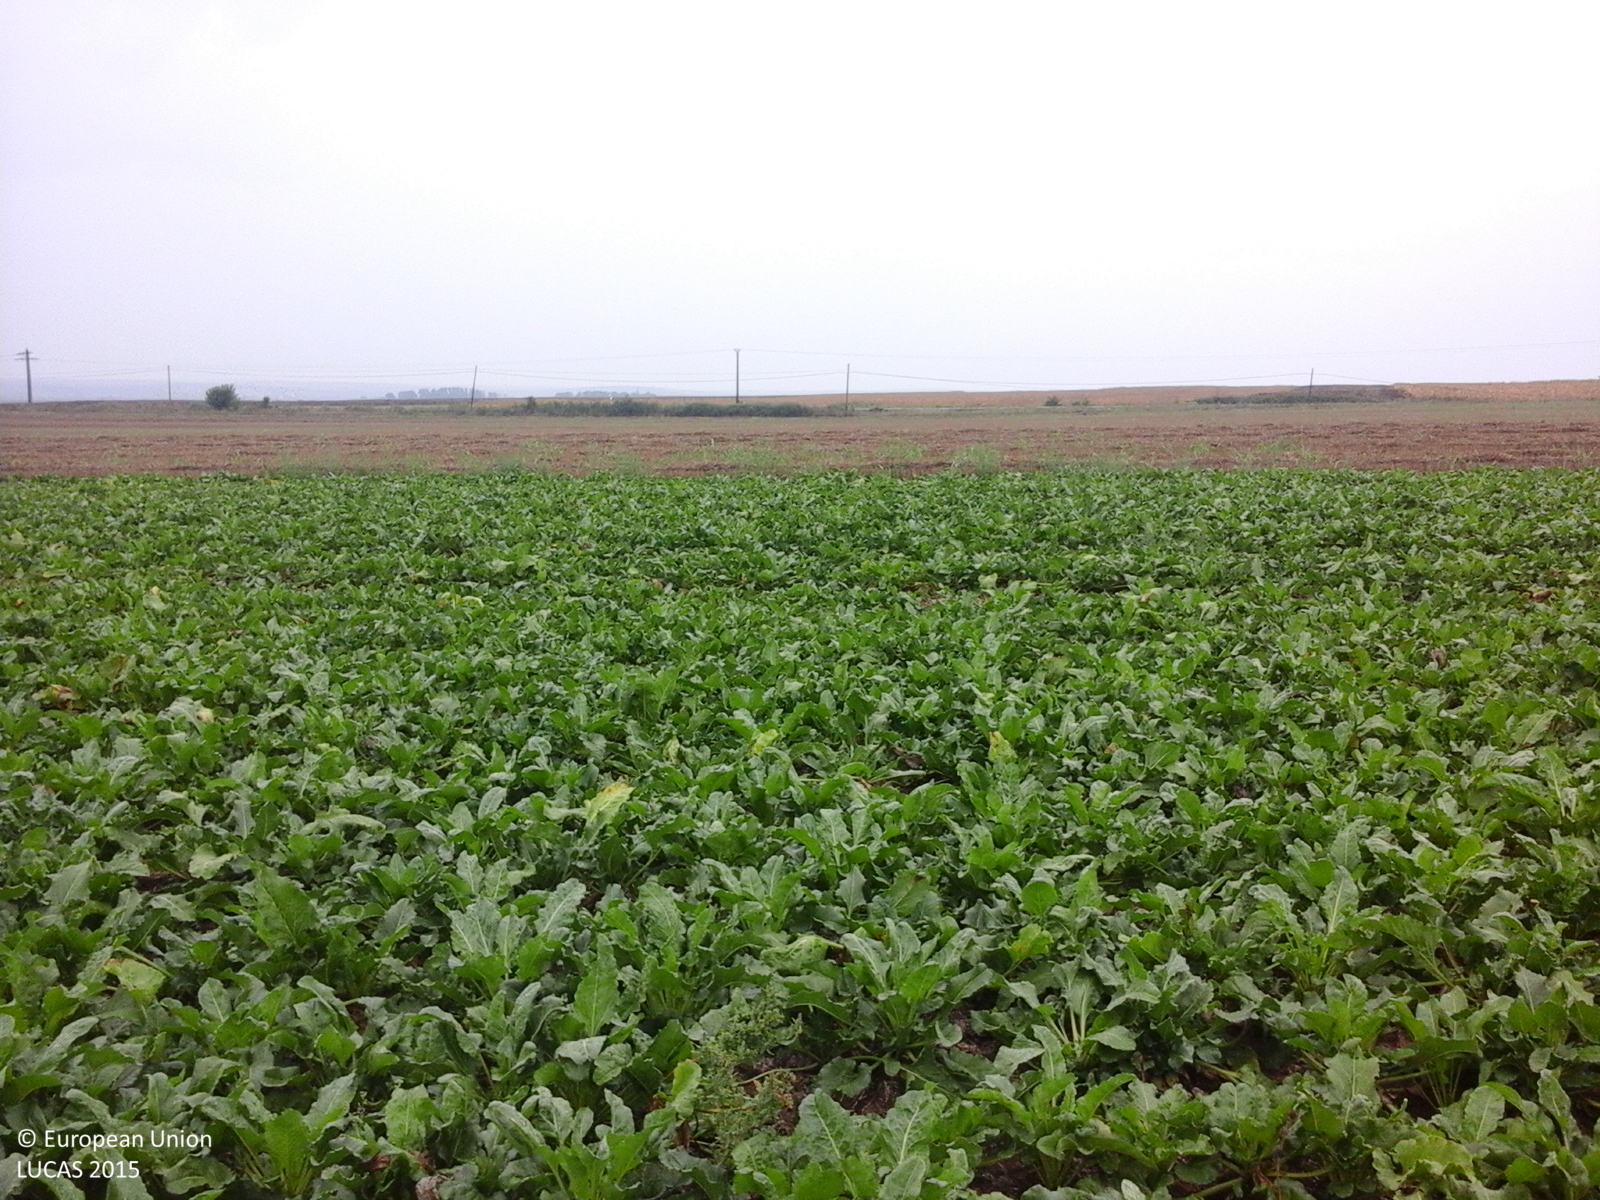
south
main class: Cropland
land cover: Sugar beet
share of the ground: > 75 %
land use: Agriculture (excluding fallow land and kitchen gardens)
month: September
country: RO
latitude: 47.3794
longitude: 22.0362
